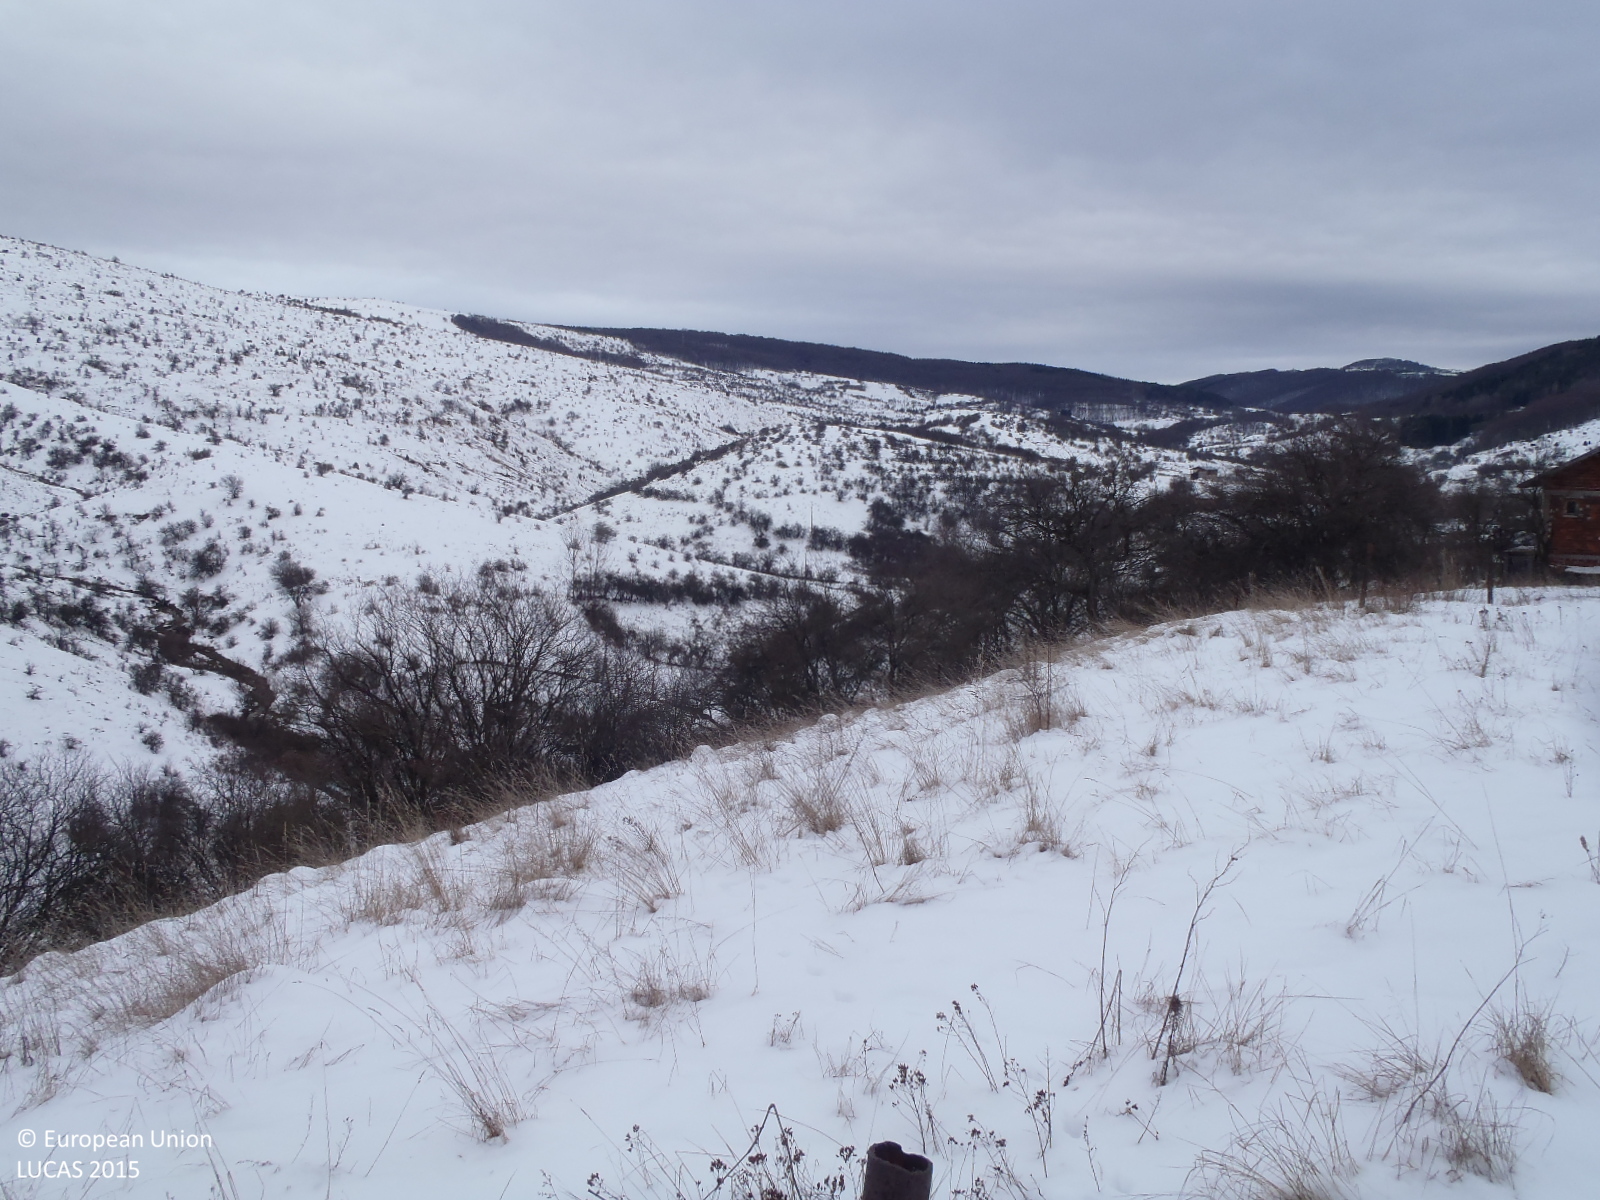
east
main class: Grassland
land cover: Grassland with sparse tree/shrub cover
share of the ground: > 75 %
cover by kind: herbaceous plants 85 %, shrubs 10 %, broadleaved forest trees 5 %
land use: Agriculture (excluding fallow land and kitchen gardens)
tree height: < 5 m
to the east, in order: Grassland with sparse tree/shrub cover; Shrubland with sparse tree cover; Broadleaved woodland
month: January
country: BG
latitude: 43.0853
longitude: 23.0425
